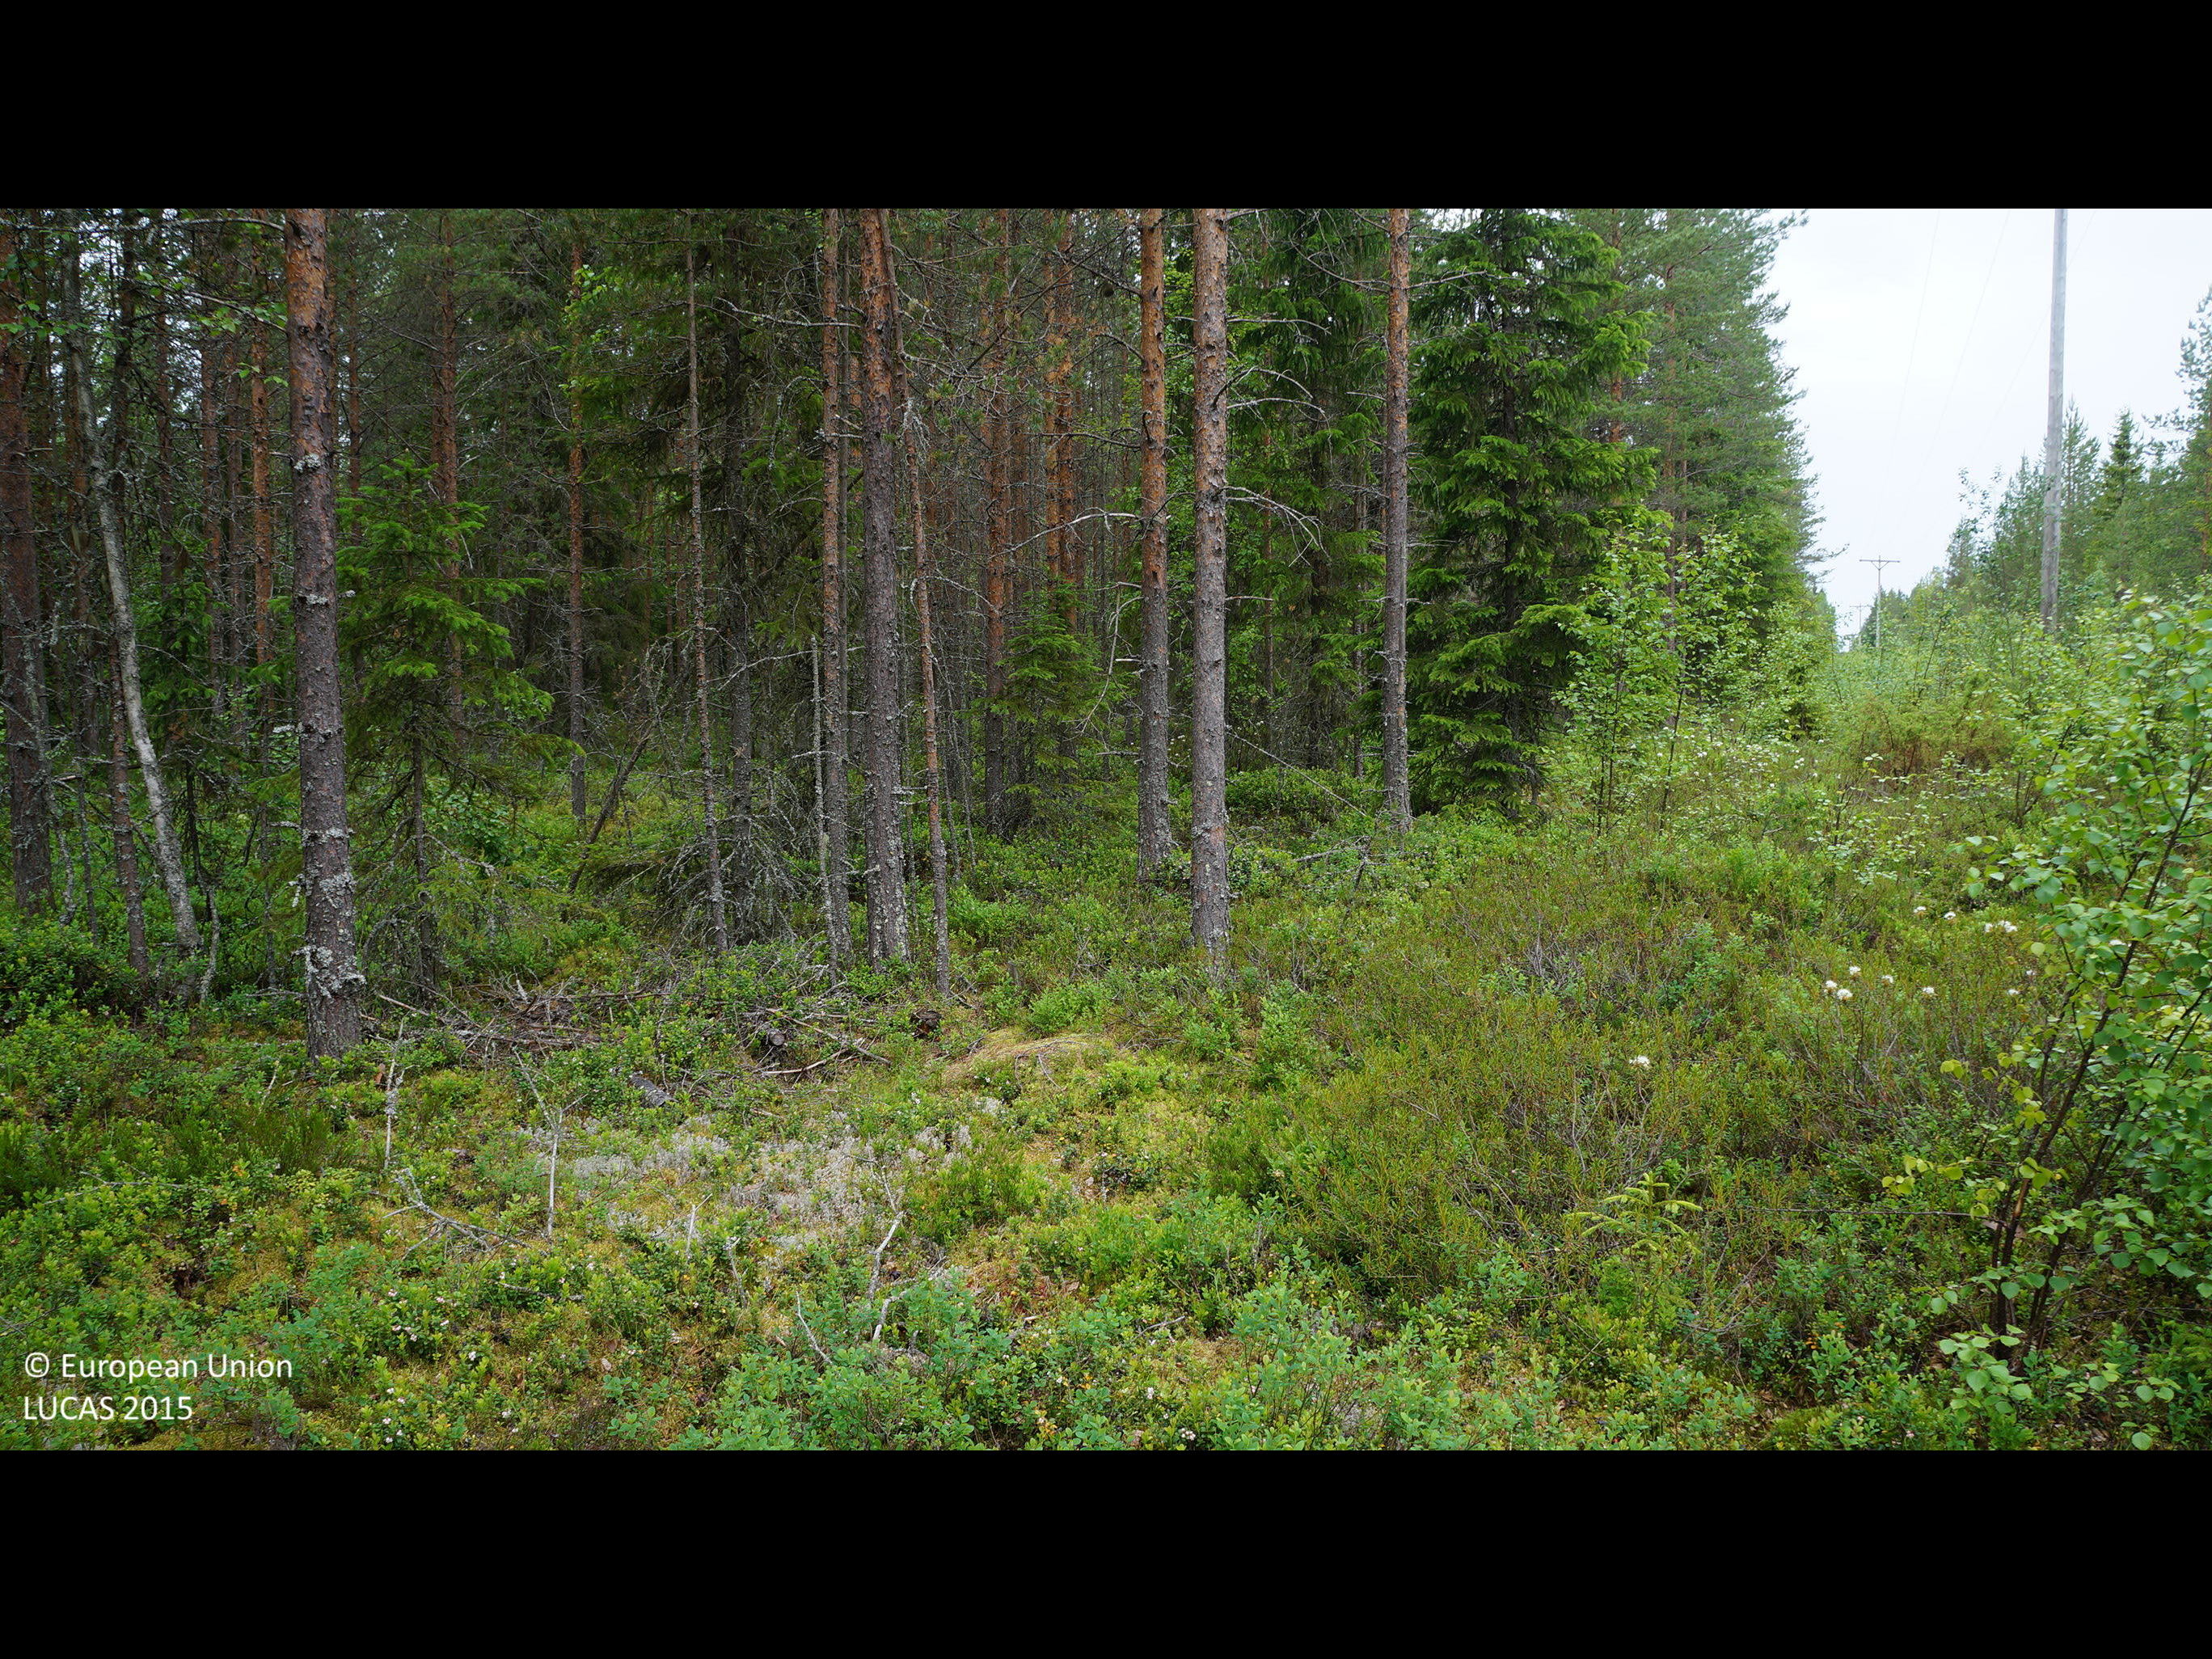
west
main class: Shrubland
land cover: Shrubland with sparse tree cover
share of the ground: > 75 %
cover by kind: shrubs 90 %, broadleaved forest trees 5 %, lichens and mosses 5 %
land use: Electricity, gas and thermal power distribution
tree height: < 5 m
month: July
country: FI
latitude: 64.2907
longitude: 24.3872
